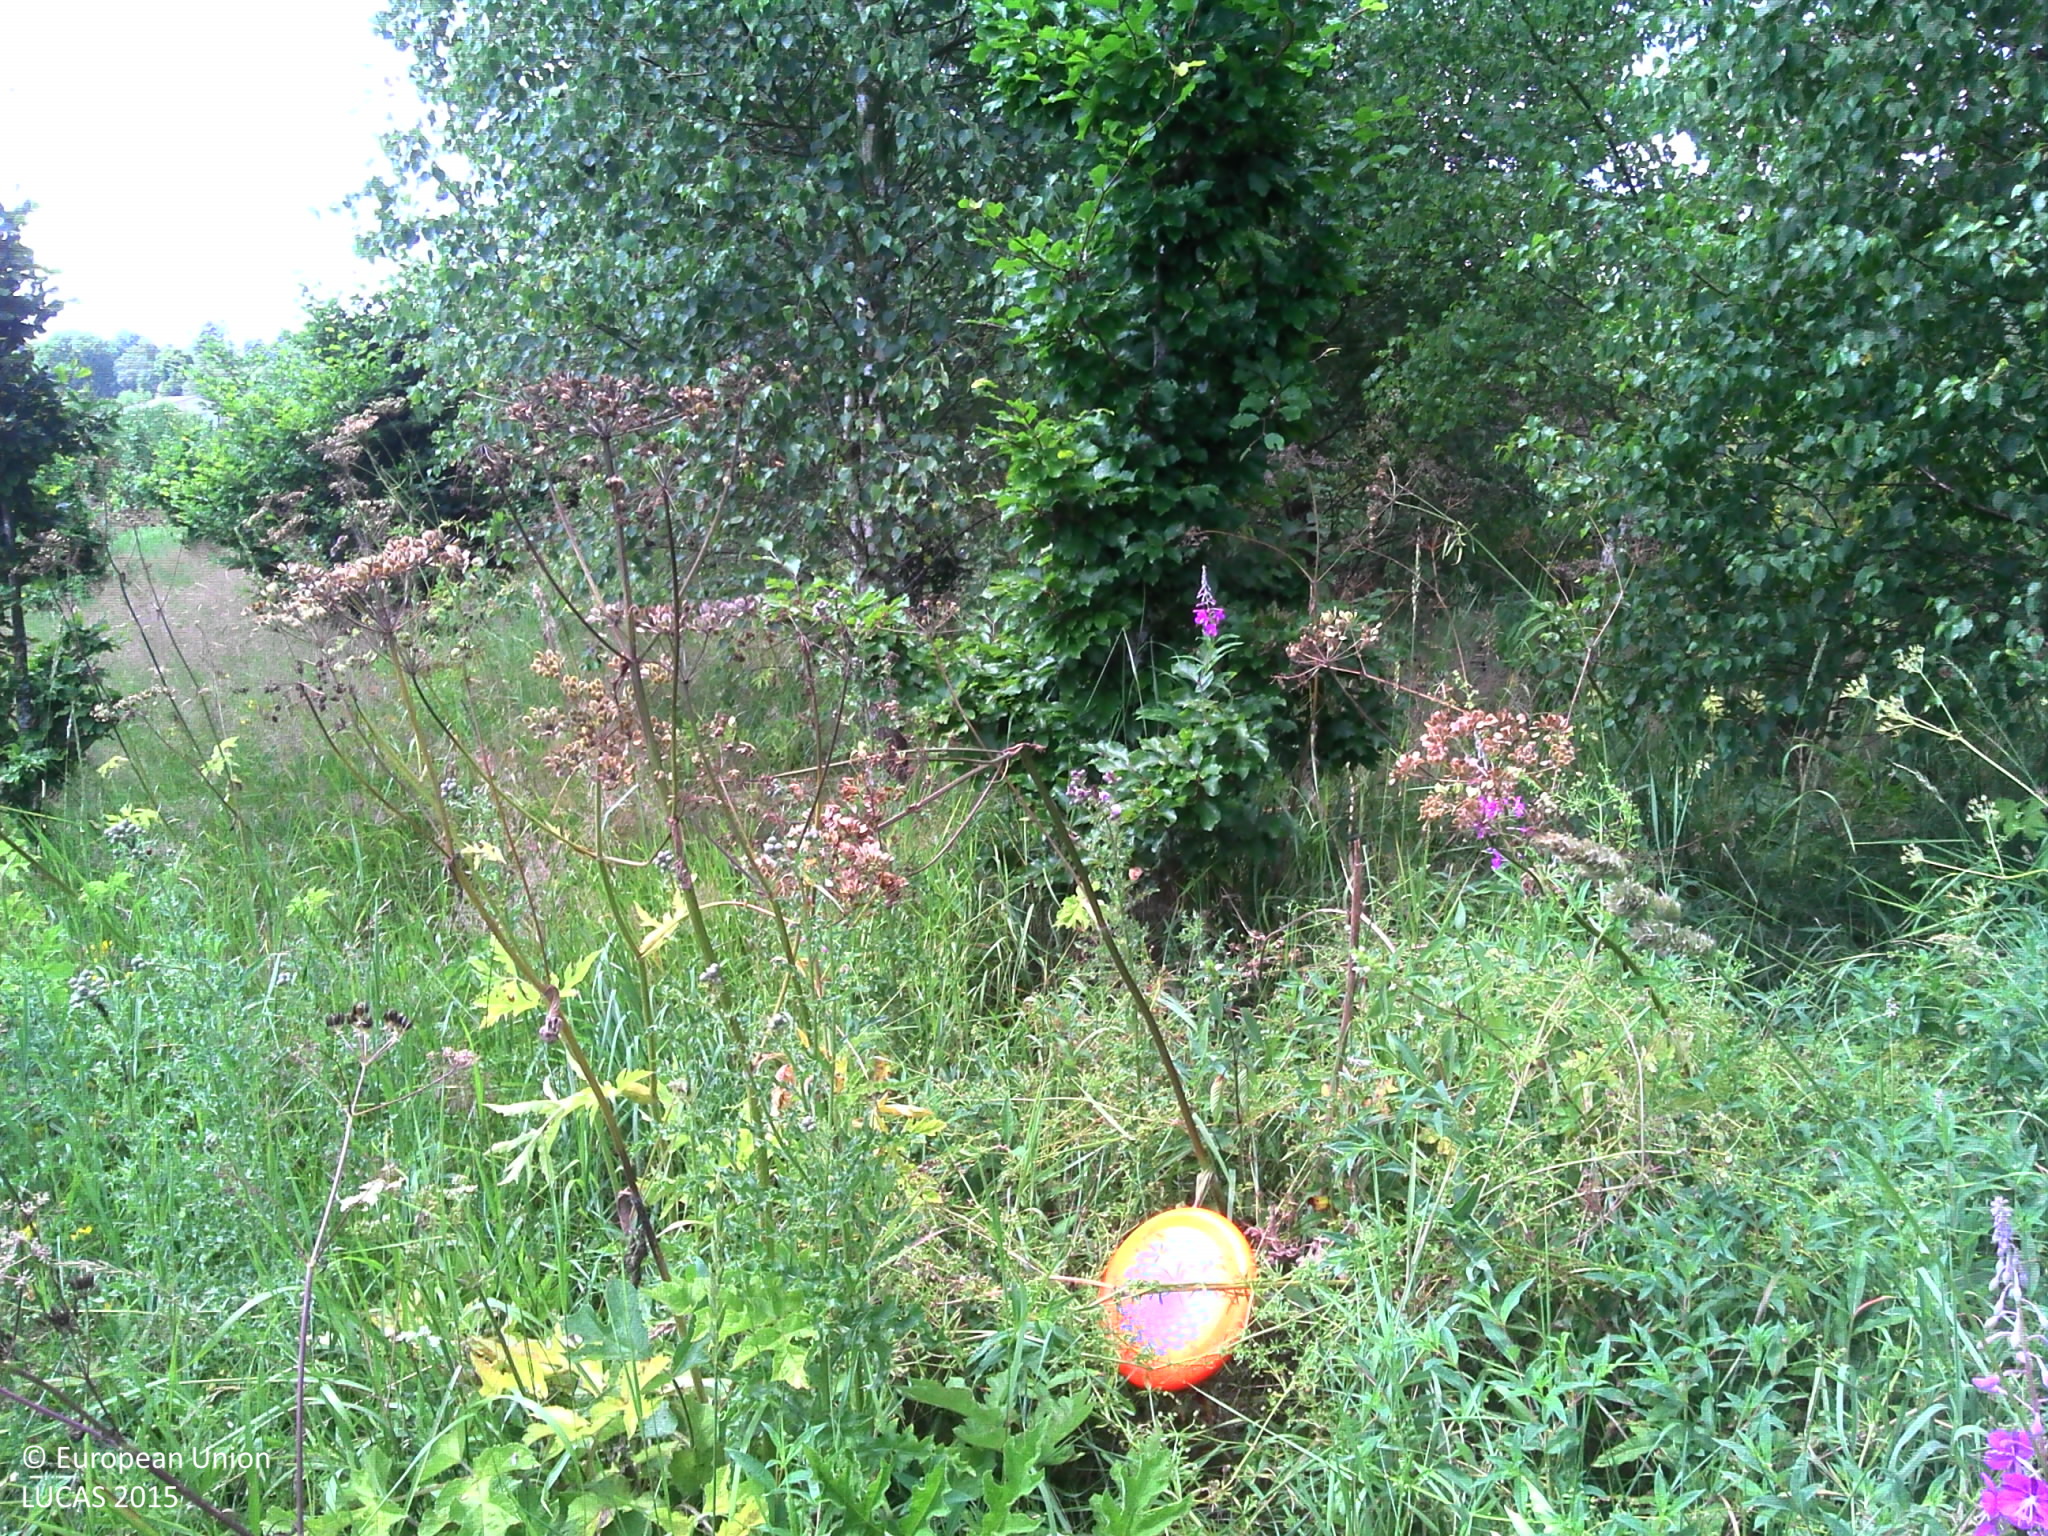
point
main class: Woodland
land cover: Broadleaved woodland
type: exotic forest
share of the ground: 10 - 25 %
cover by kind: herbaceous plants 75 %, broadleaved forest trees 20 %, shrubs 5 %
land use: Forestry
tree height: < 5 m
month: July
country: BE
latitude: 49.9989
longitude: 5.7996
